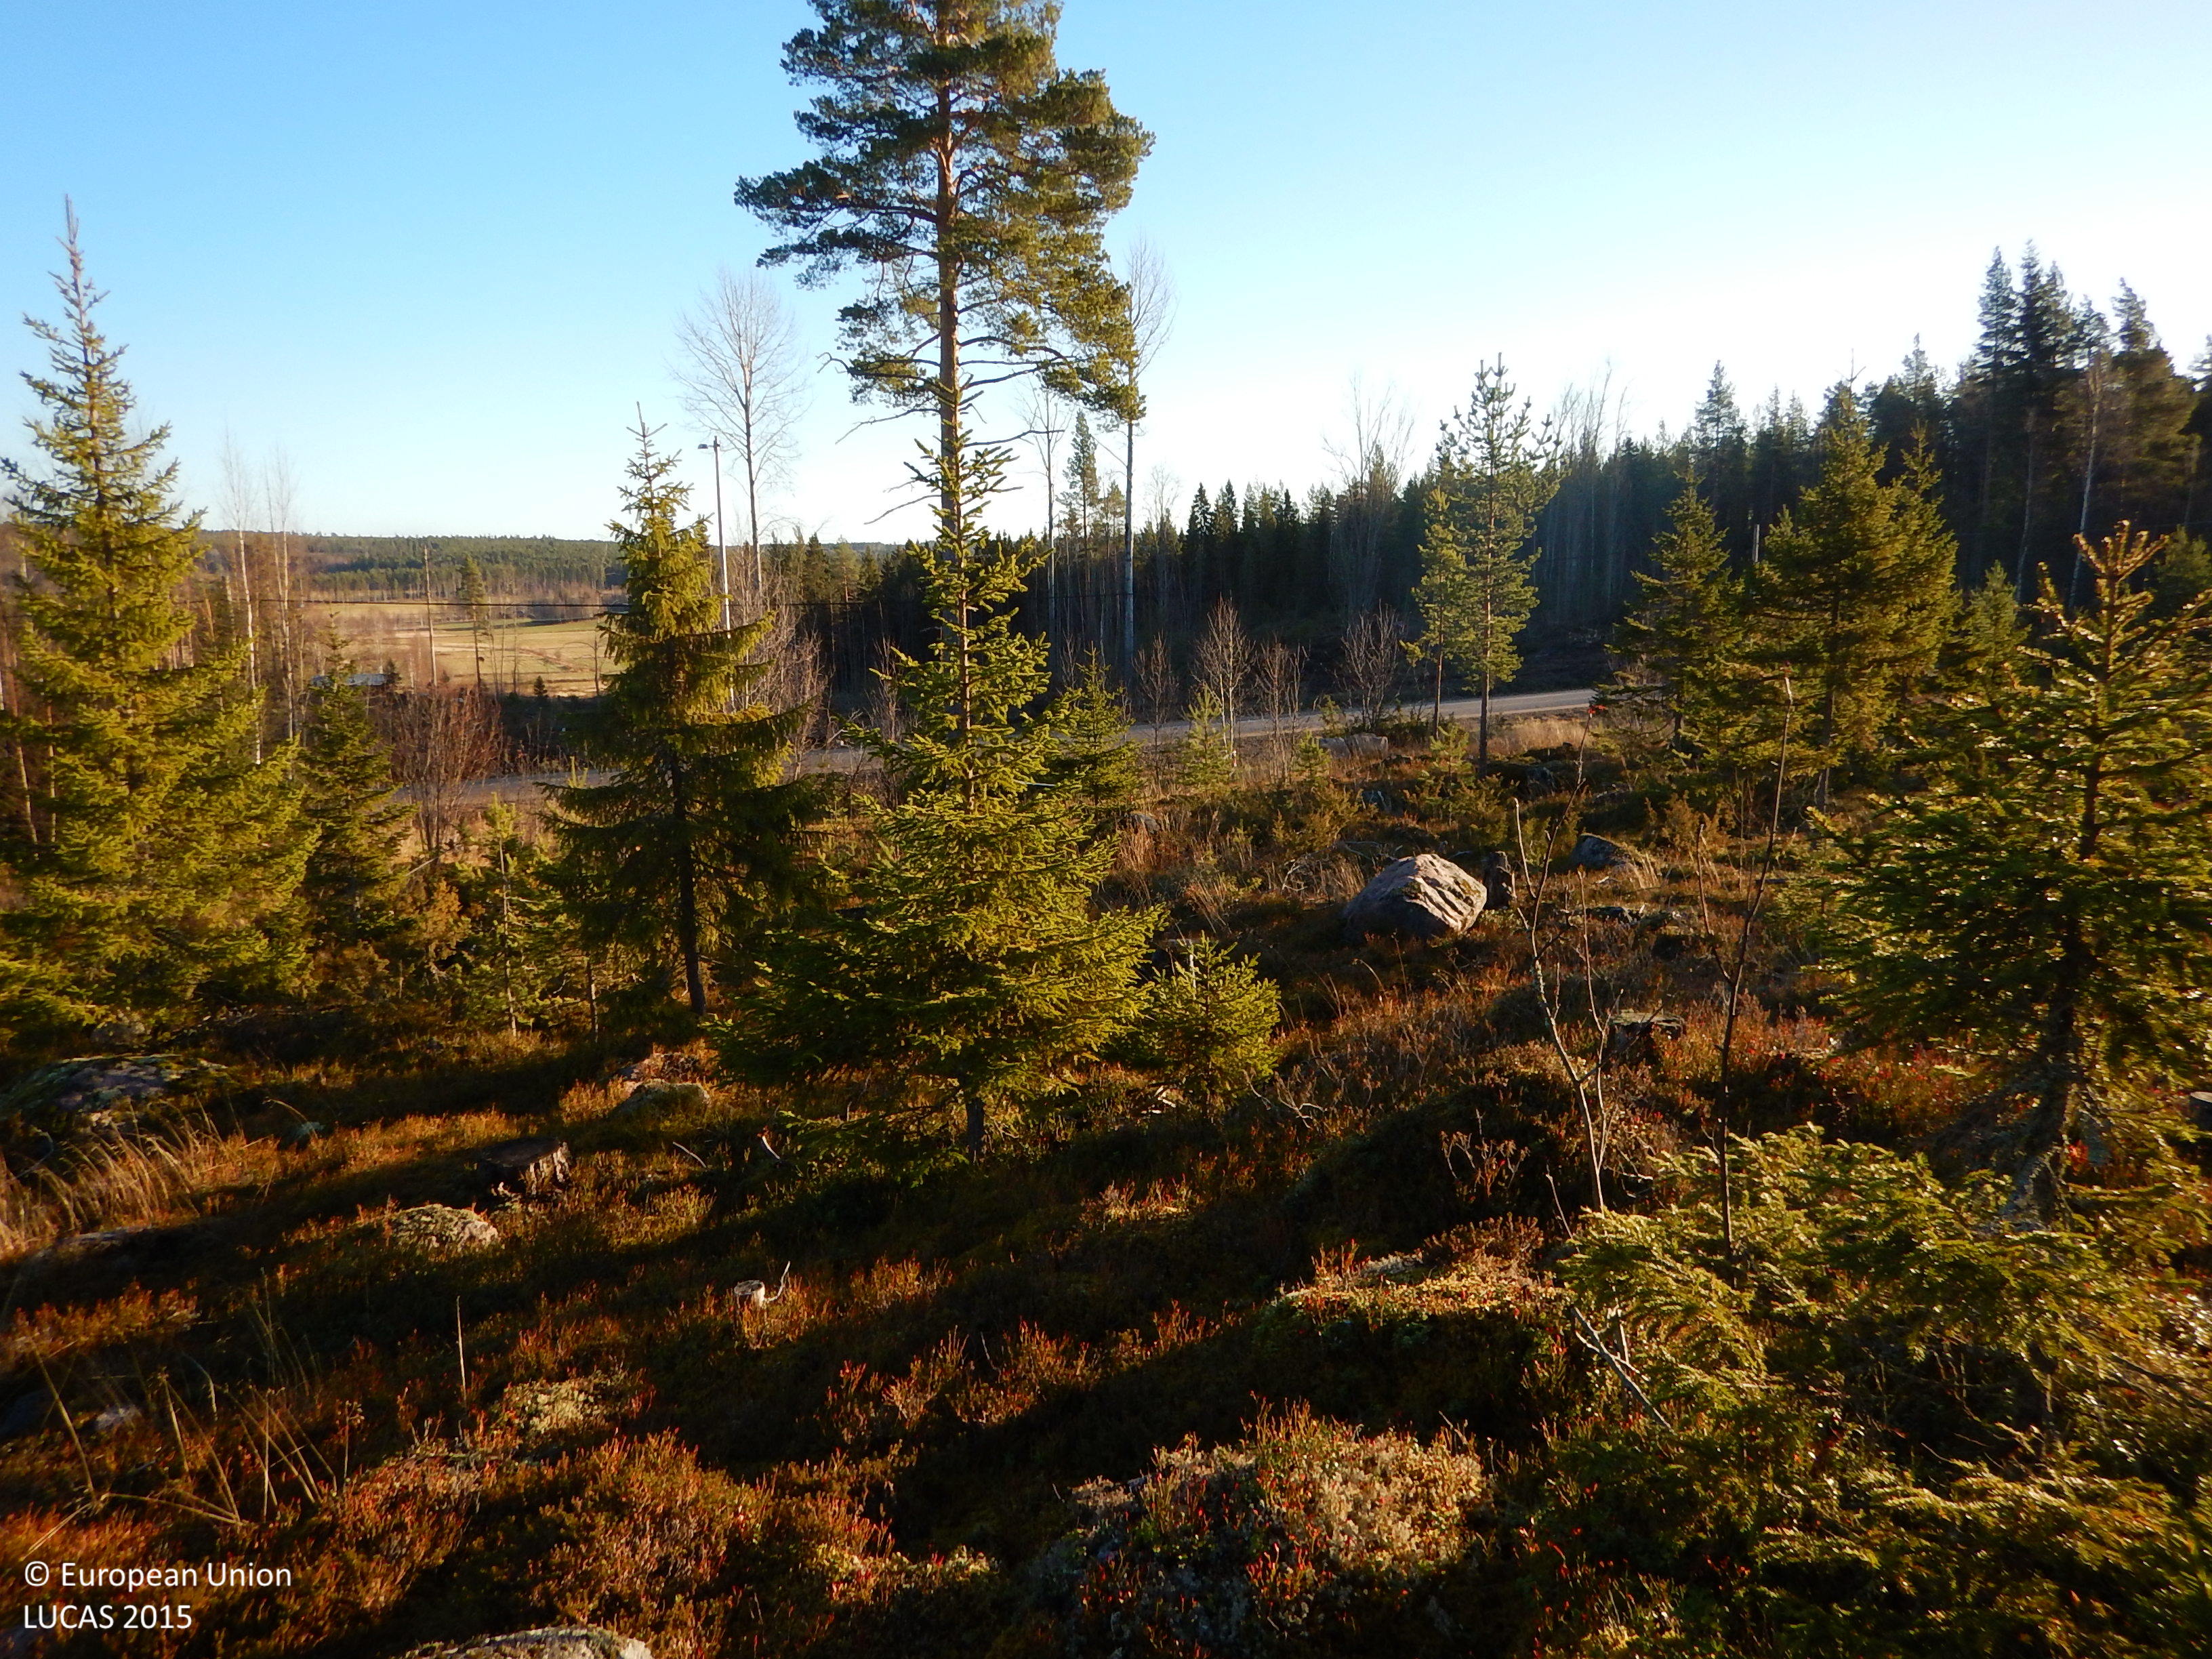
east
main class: Woodland
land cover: Other coniferous woodland
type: boreal forest
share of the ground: 25 - 50 %
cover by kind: coniferous forest trees 30 %, shrubs 30 %, herbaceous plants 20 %, lichens and mosses 20 %
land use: Forestry
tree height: < 5 m
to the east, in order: Other coniferous woodland; Electric lines; Grass margins; Ditches and canals; Paved roads, cycling and walking lanes; Grass margins; Ditches and canals; Shrubland with sparse tree cover; Tracks; Shrubland with sparse tree cover; Spruce dominated coniferous woodland
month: November
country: SE
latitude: 65.2966
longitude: 21.2328
